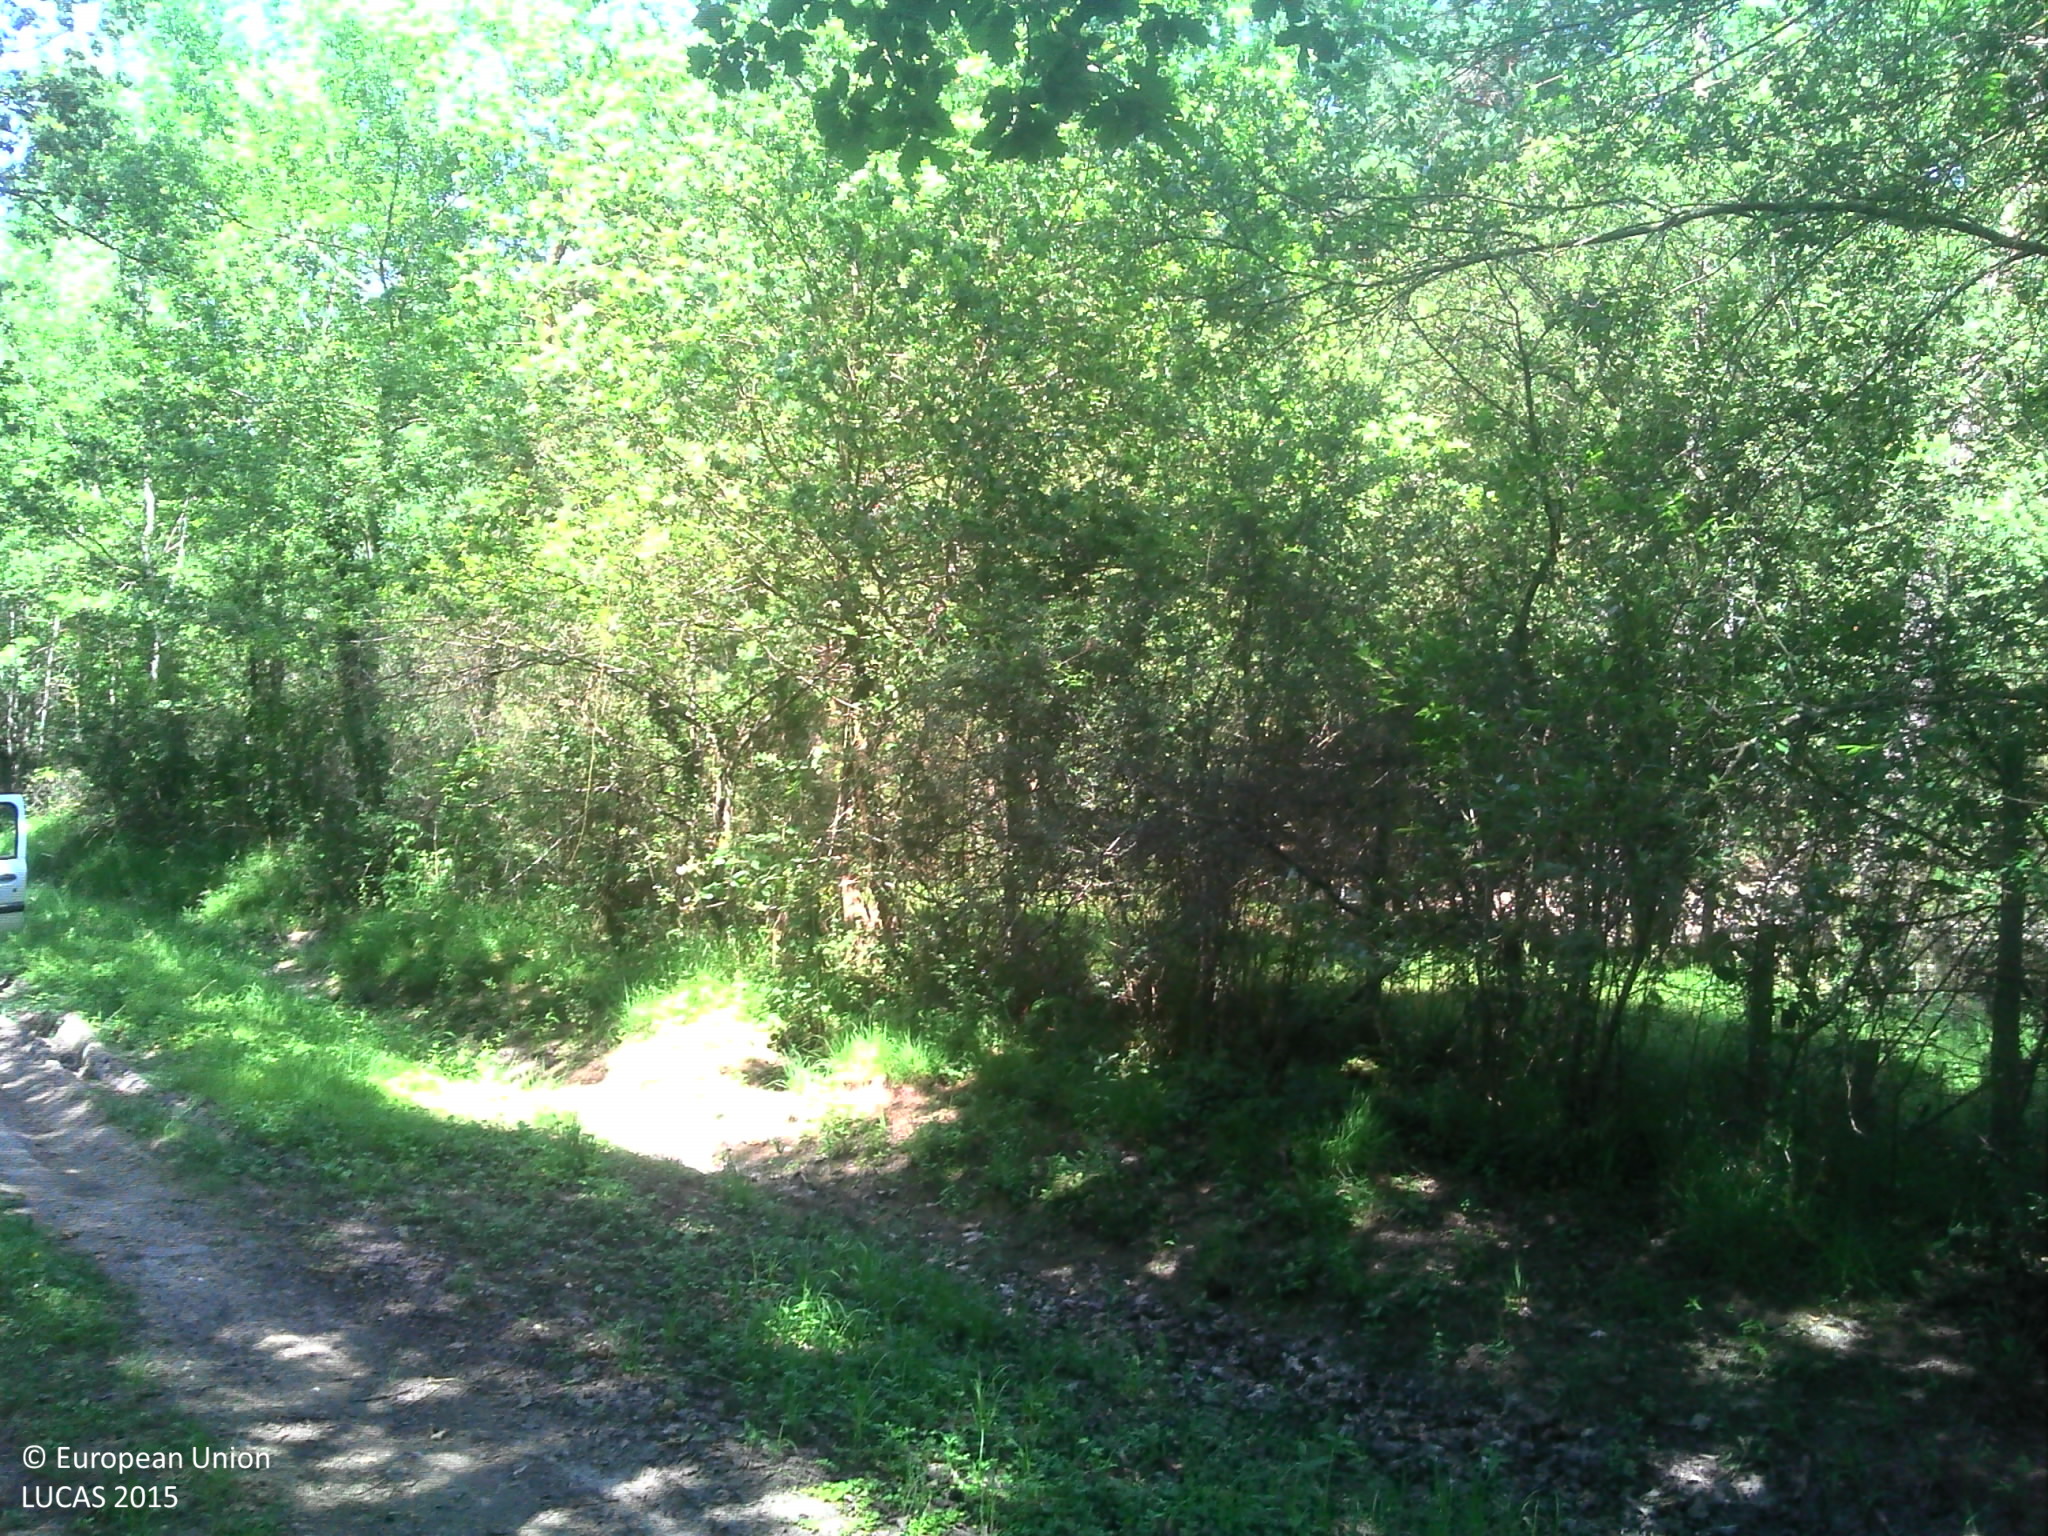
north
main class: Woodland
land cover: Pine dominated mixed woodland
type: thermophilous deciduous forest
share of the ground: > 75 %
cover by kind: herbaceous plants 50 %, unconsolidated bare surface 30 %, coniferous forest trees 10 %, broadleaved forest trees 10 %
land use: Forestry
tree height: > 5 m
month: June
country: FR
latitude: 47.4414
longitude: 1.4863
